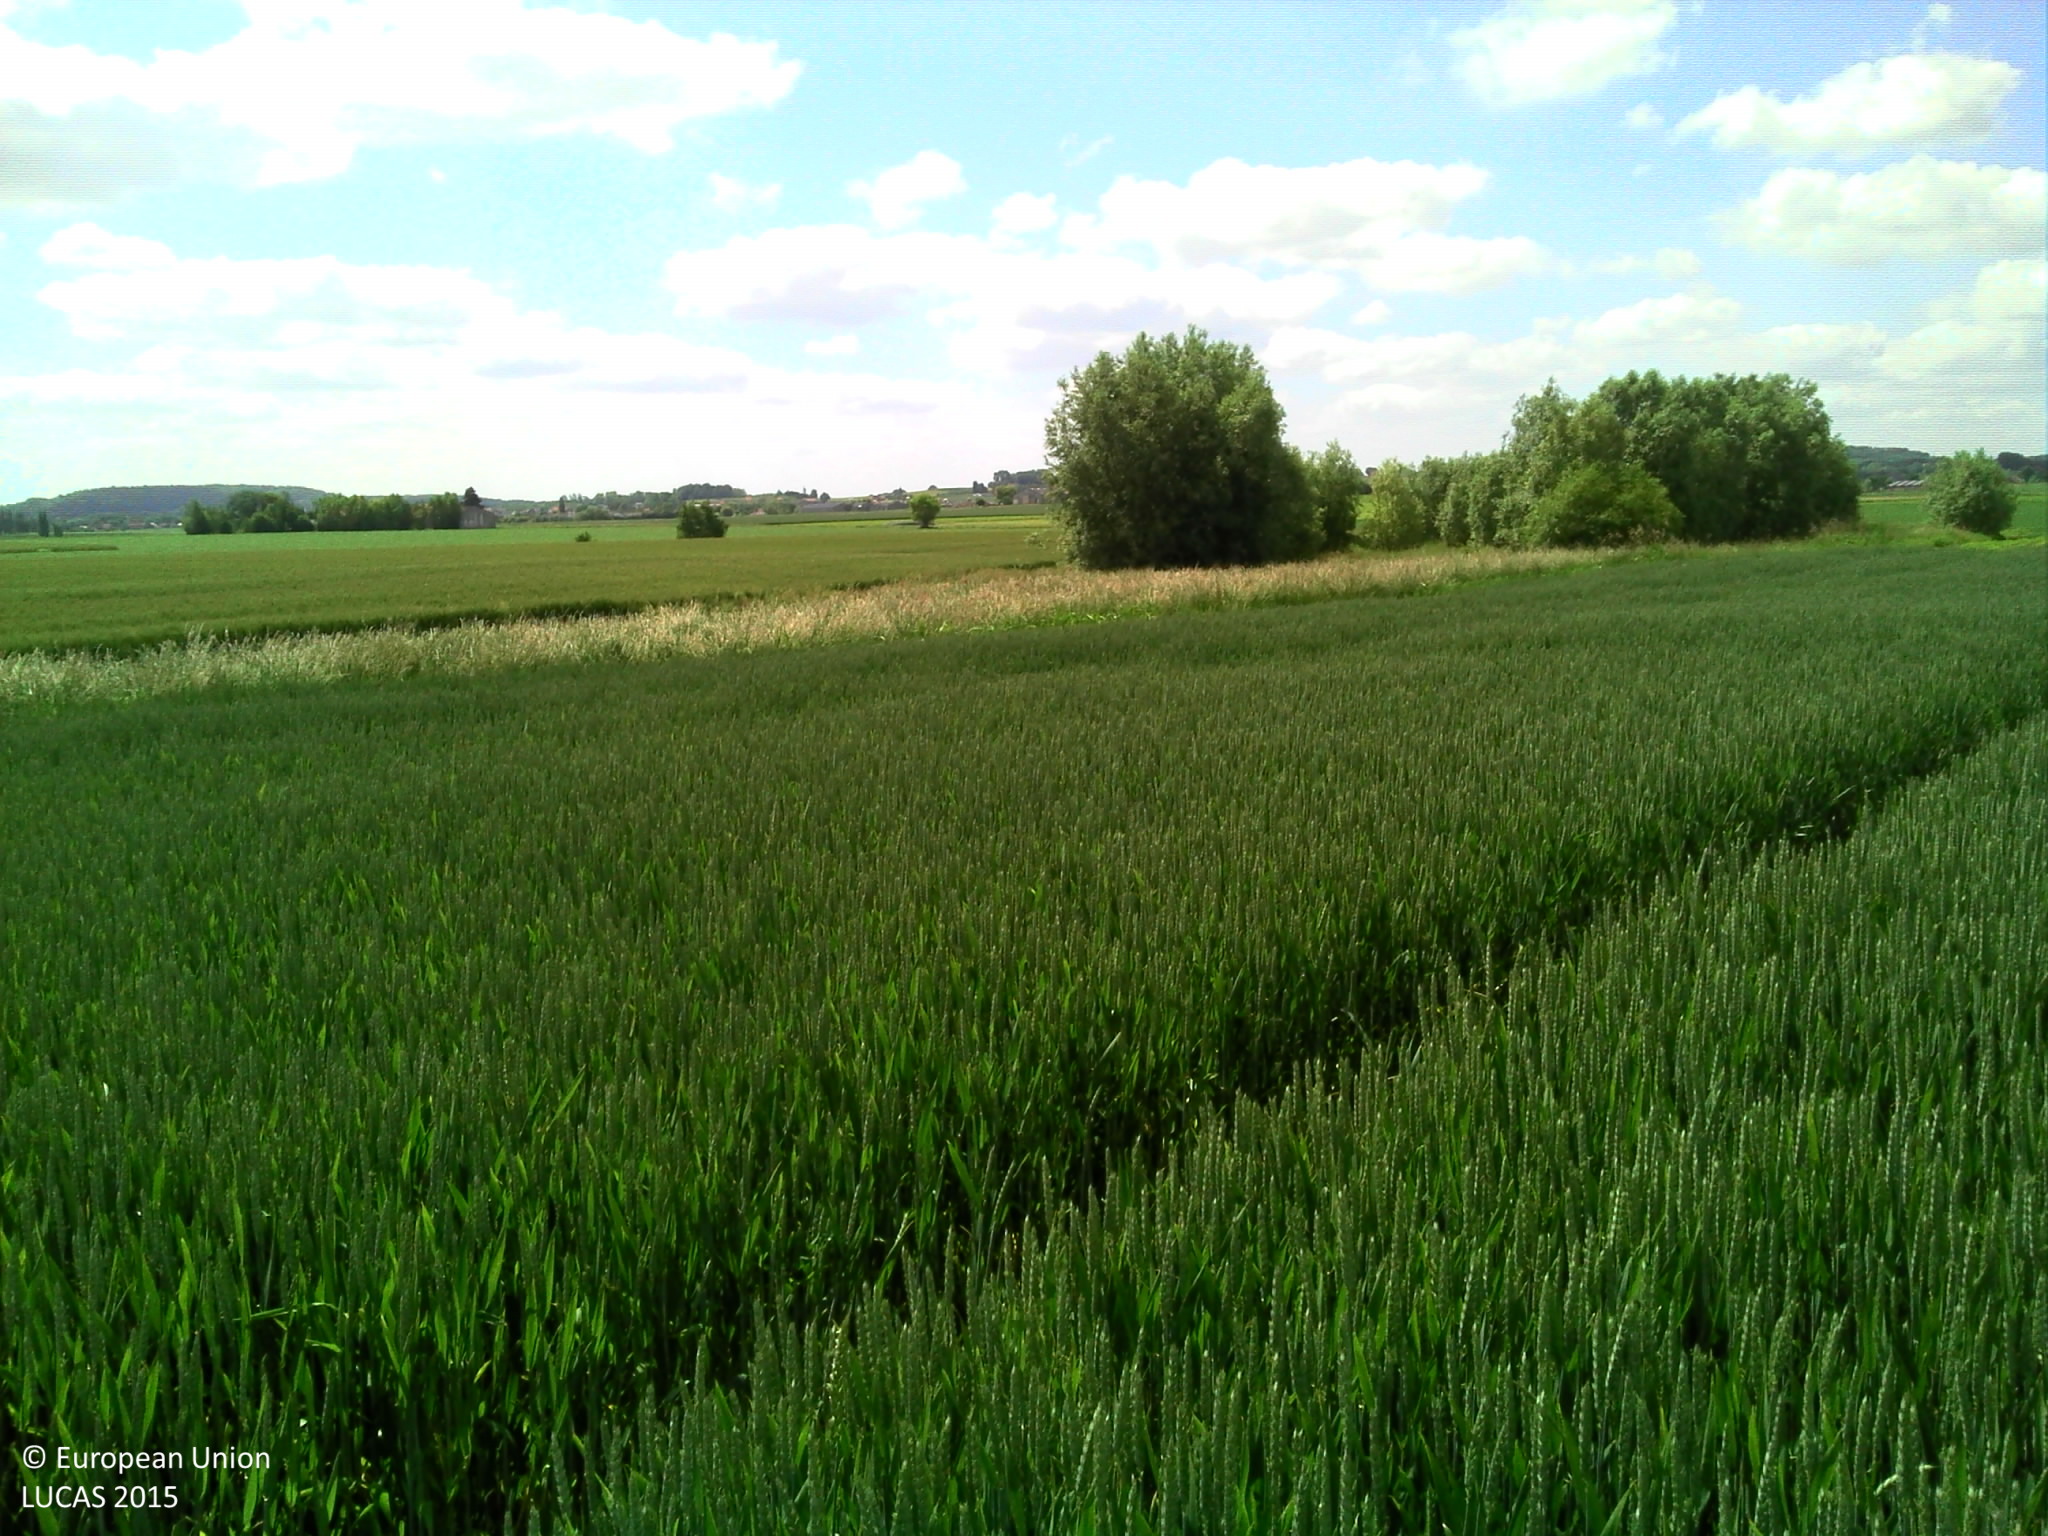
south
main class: Cropland
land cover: Common wheat
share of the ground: > 75 %
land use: Agriculture (excluding fallow land and kitchen gardens)
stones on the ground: < 10 %
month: June
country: BE
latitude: 50.8225
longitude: 2.7917
